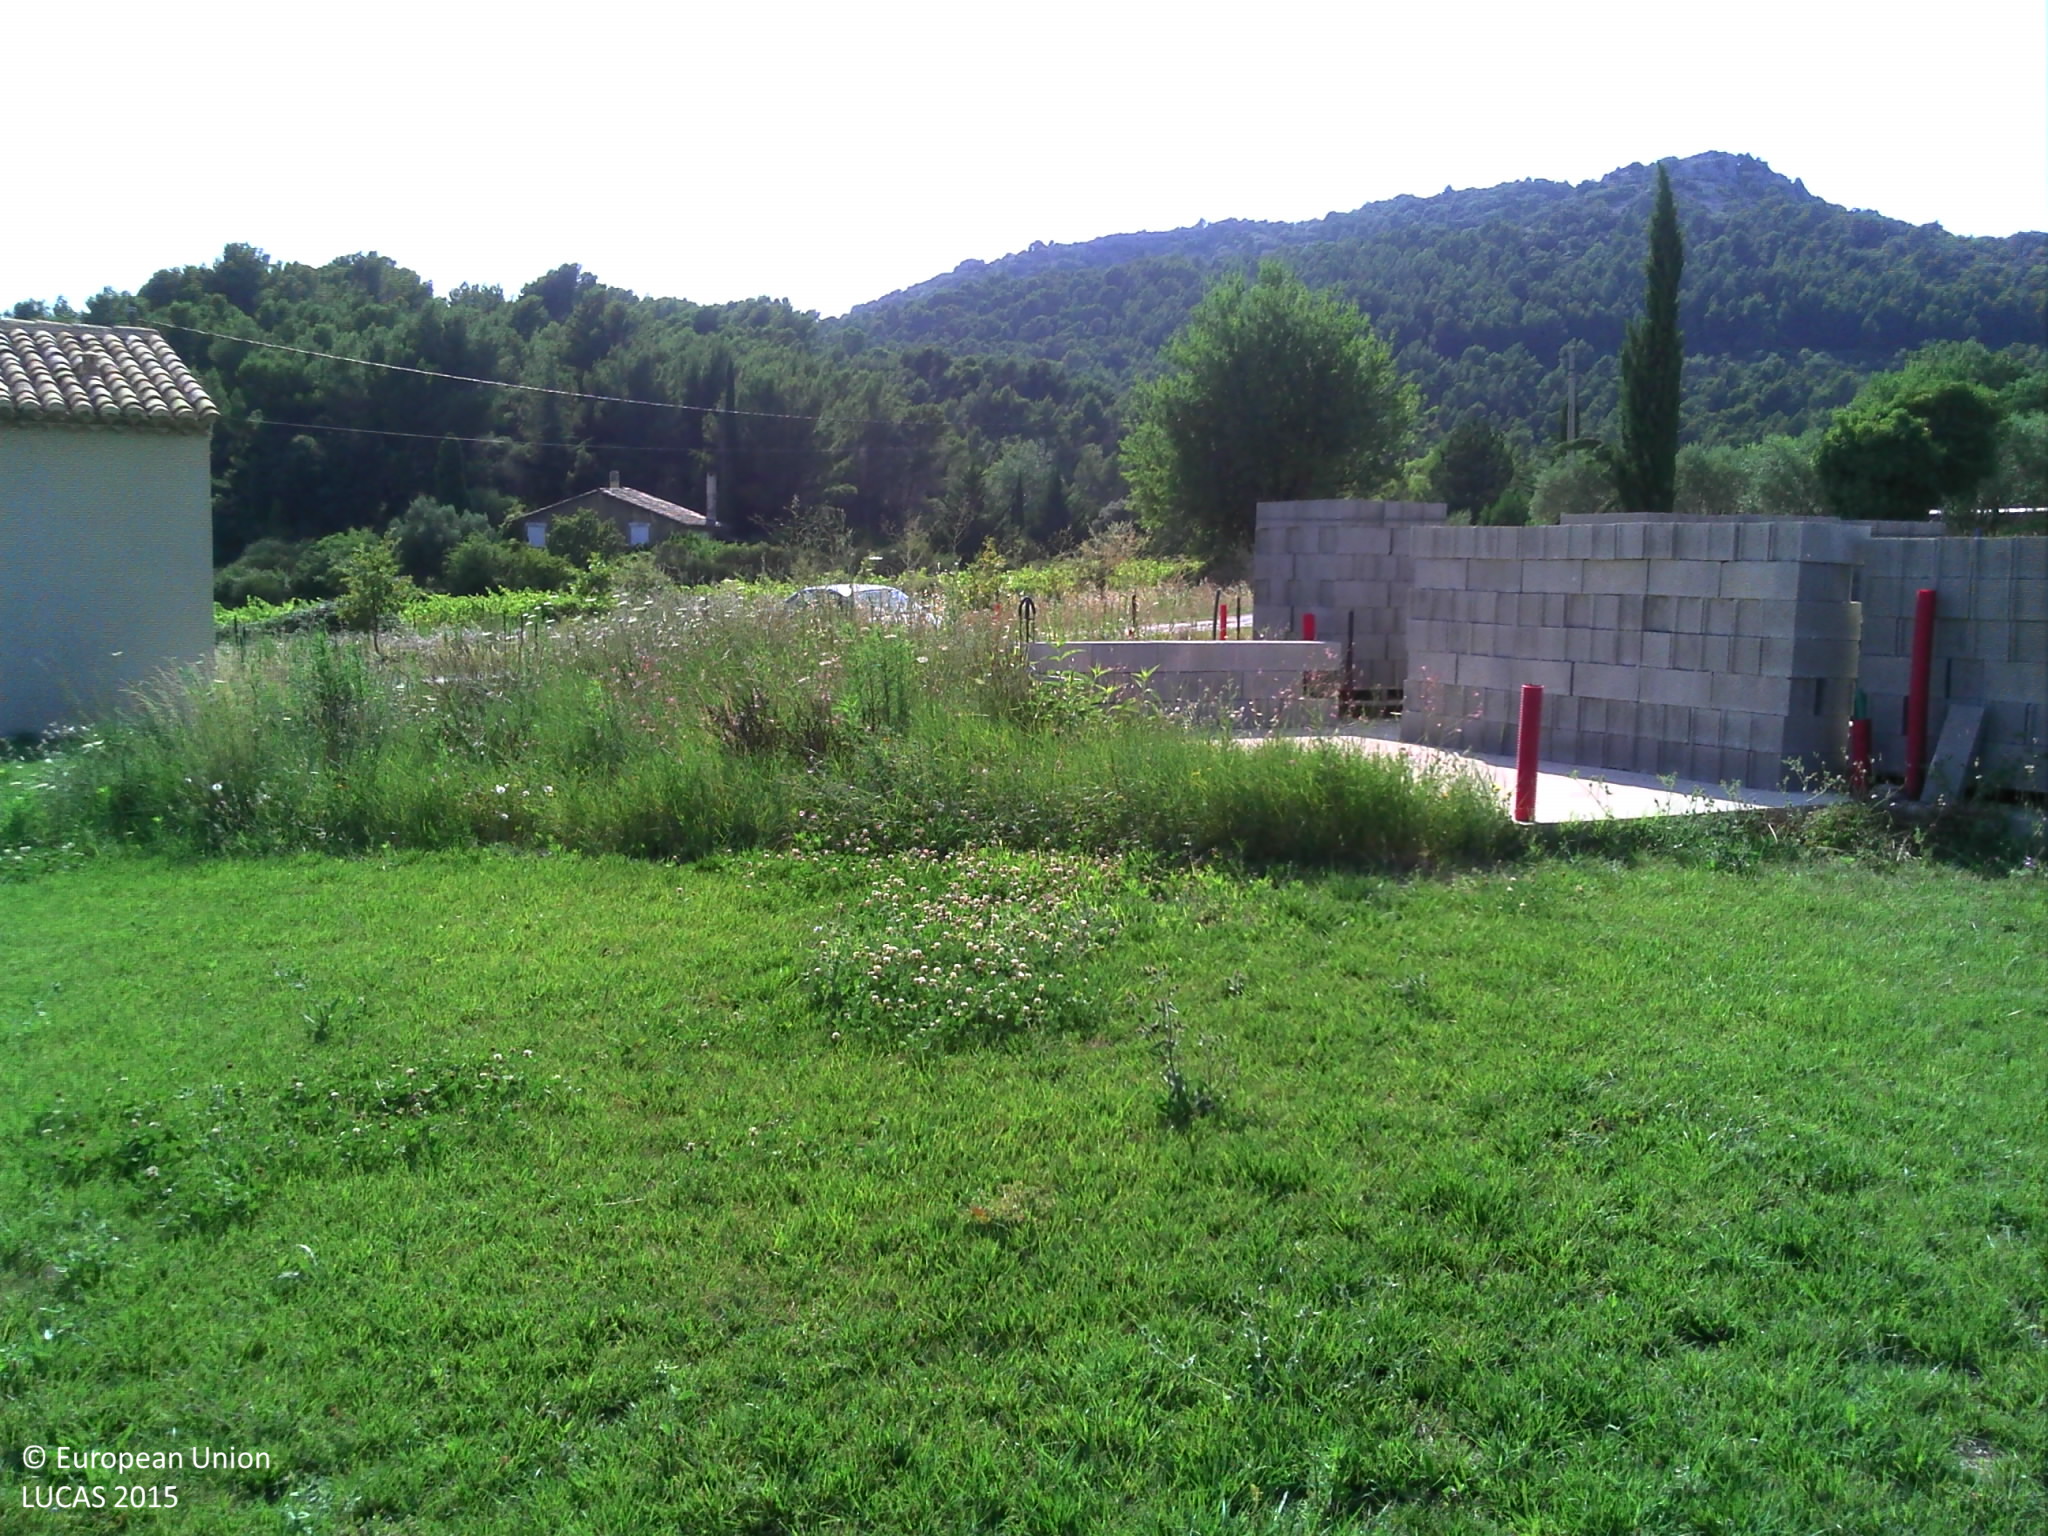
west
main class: Grassland
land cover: Grassland without tree/shrub cover
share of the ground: > 75 %
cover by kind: herbaceous plants 100 %
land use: Residential
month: July
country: FR
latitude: 44.1443
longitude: 5.0950
